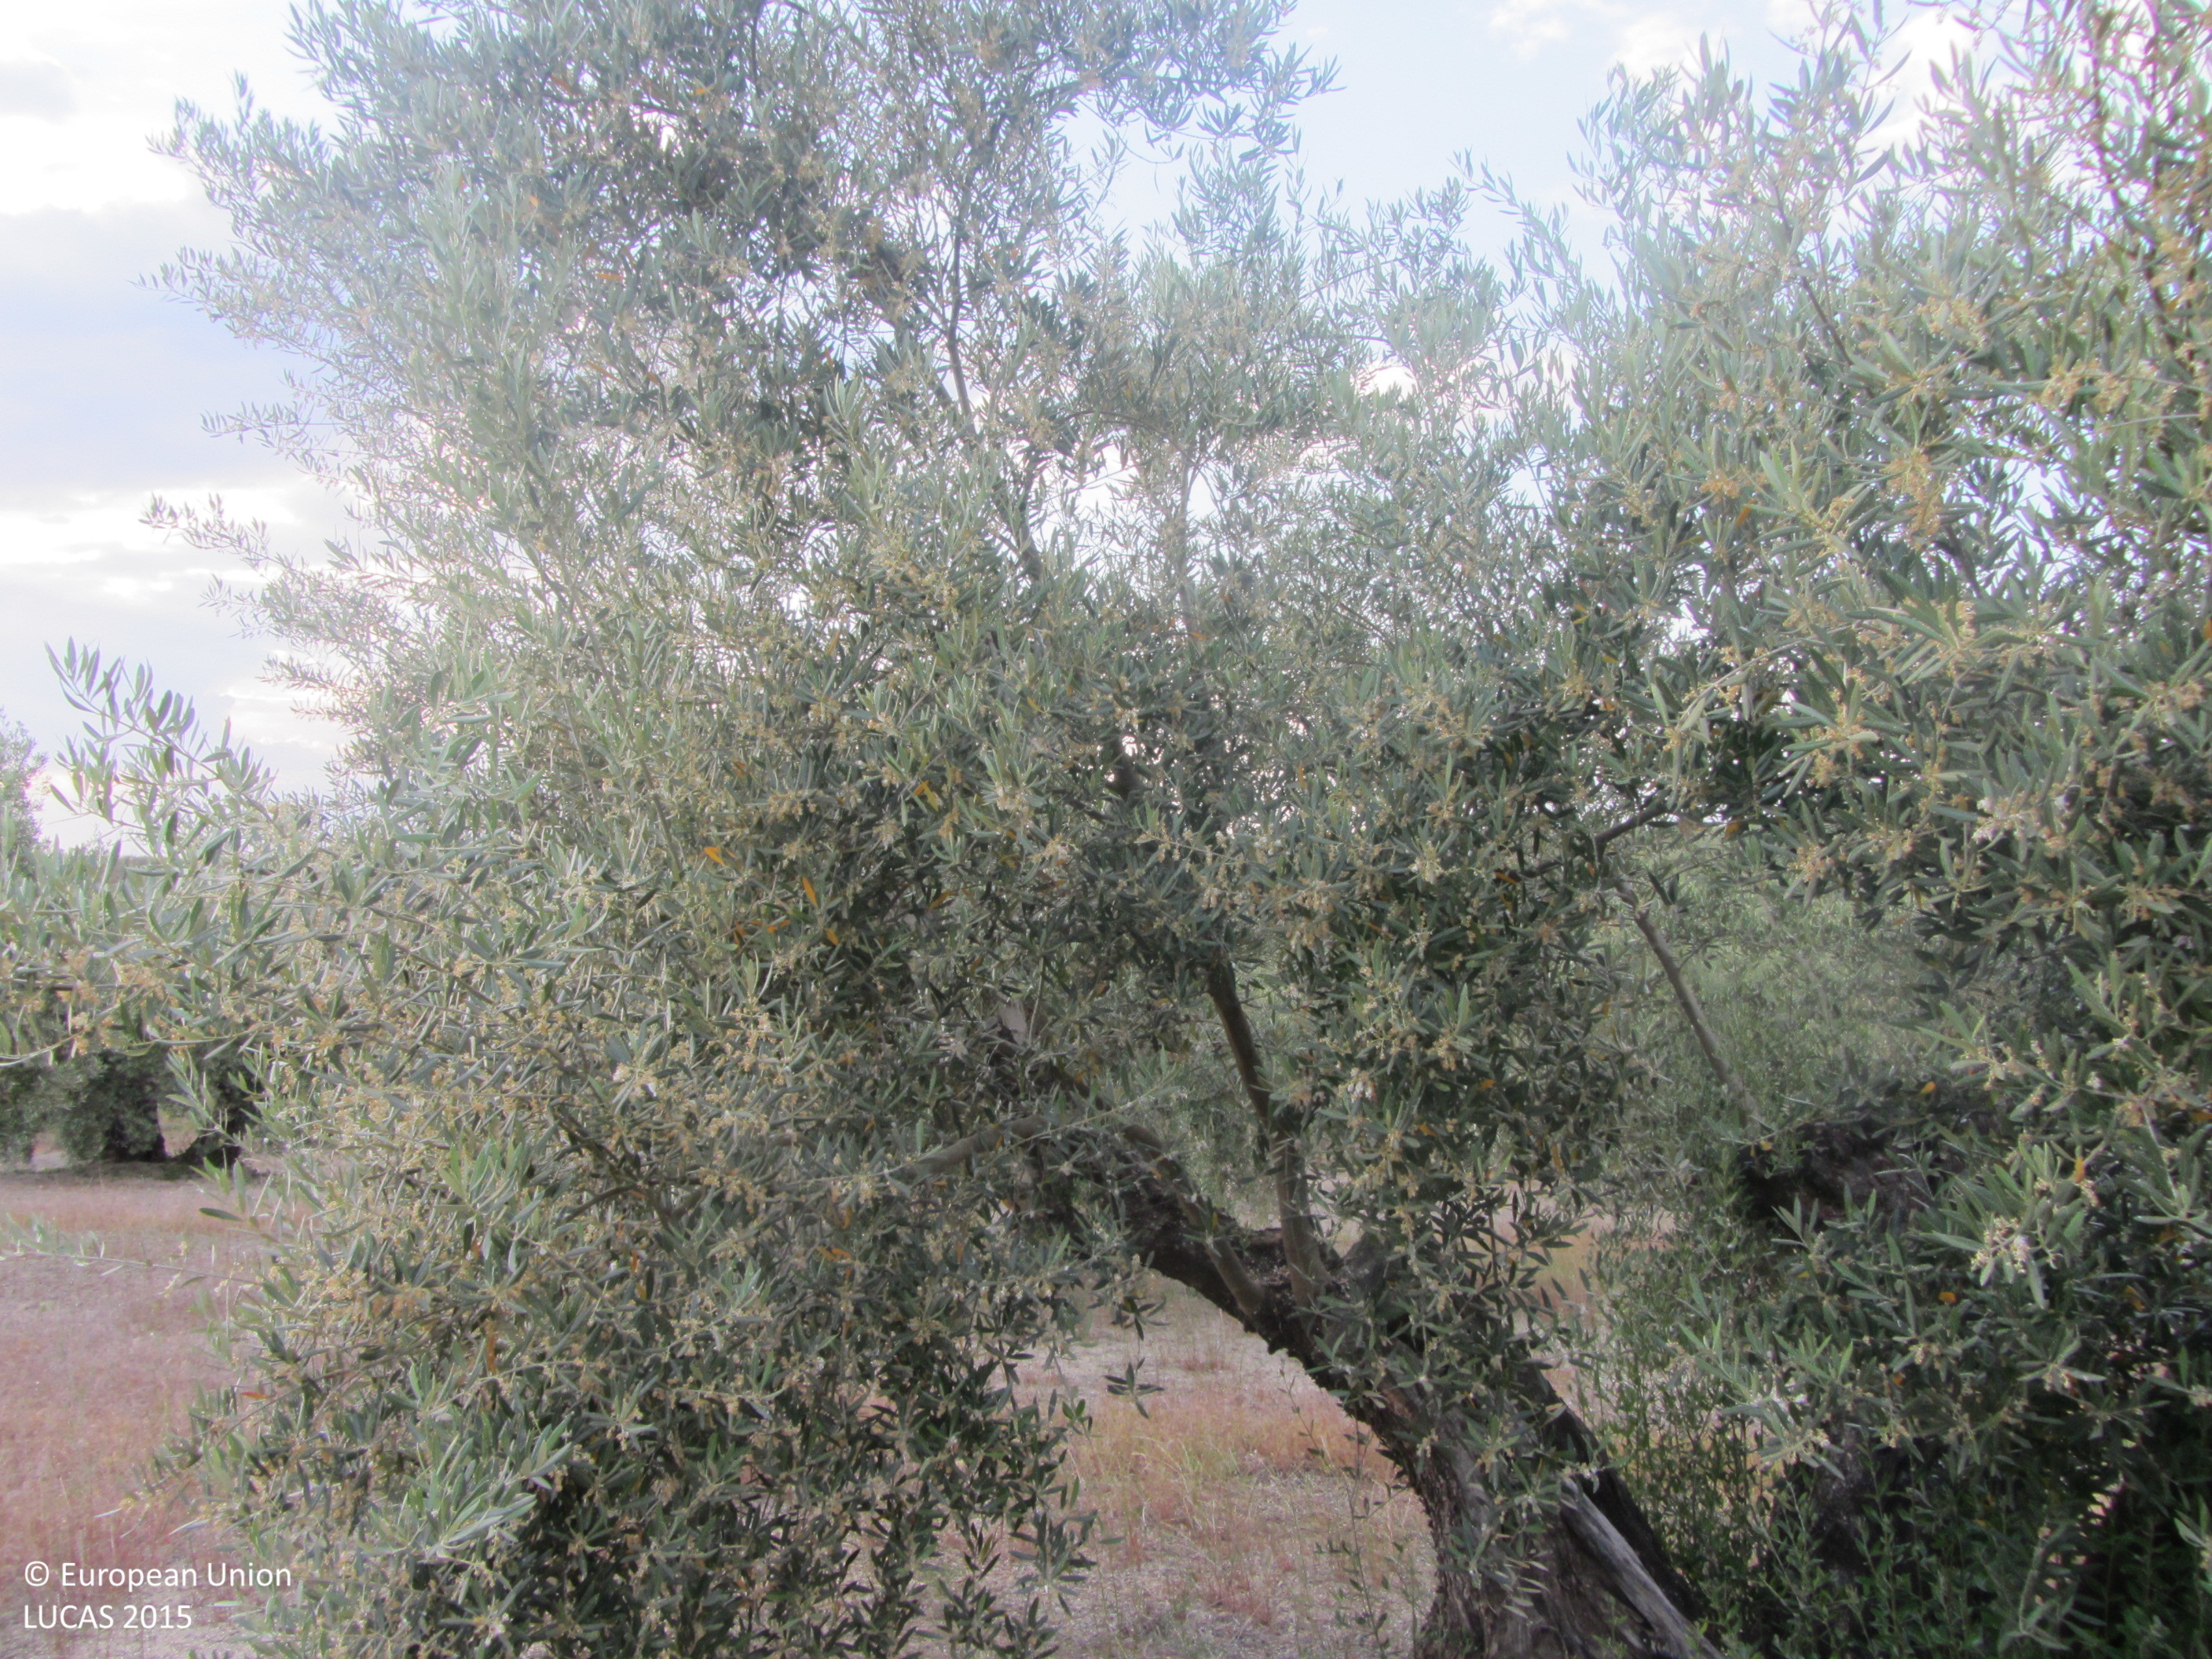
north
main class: Cropland
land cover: Olive groves
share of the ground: 25 - 50 %
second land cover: Spontaneously vegetated surfaces
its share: 10 - 25 %
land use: Agriculture (excluding fallow land and kitchen gardens)
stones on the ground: < 10 %
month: May
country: ES
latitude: 38.1589
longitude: -3.0898
